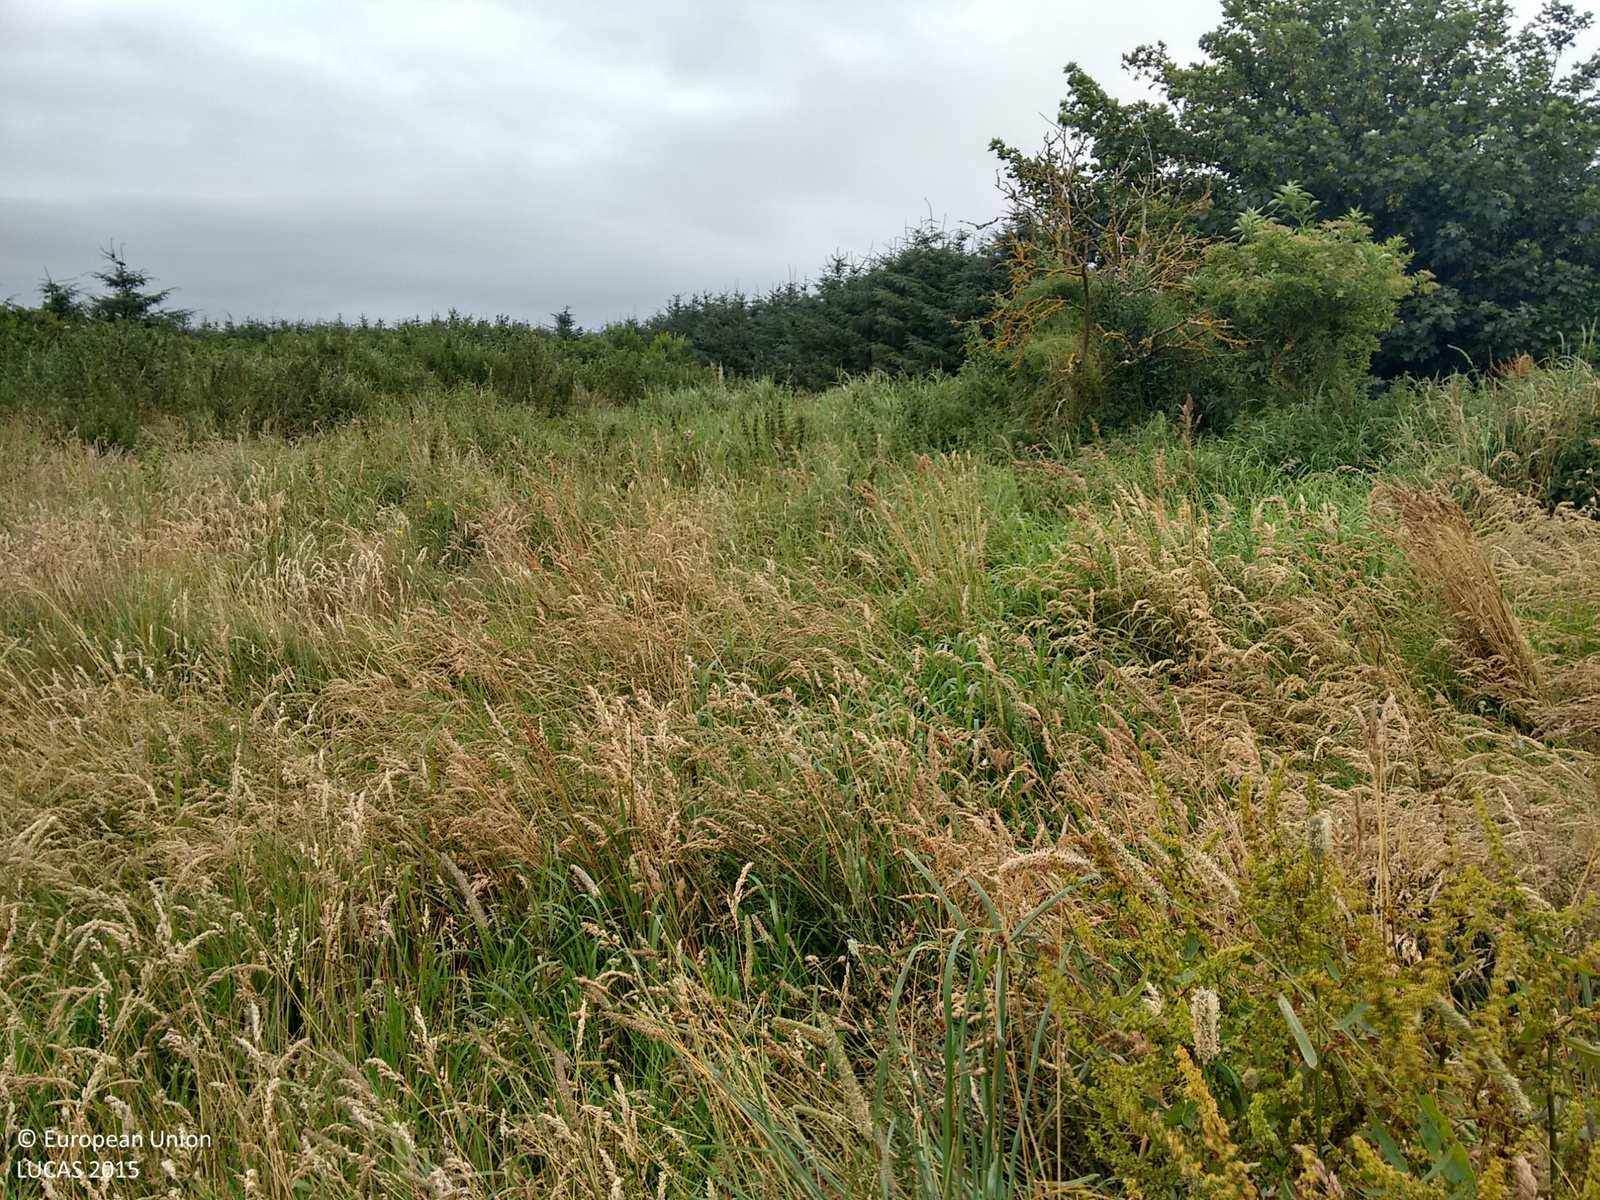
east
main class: Grassland
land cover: Grassland without tree/shrub cover
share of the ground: > 75 %
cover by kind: herbaceous plants 100 %
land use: Forestry
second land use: Agriculture (excluding fallow land and kitchen gardens)
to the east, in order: Grassland without tree/shrub cover; Ditches and canals; Shrubland with sparse tree cover; Ditches and canals; Grassland without tree/shrub cover; Other coniferous woodland; Fences; Grassland without tree/shrub cover
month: August
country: GB
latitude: 57.8007
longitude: -3.9248
